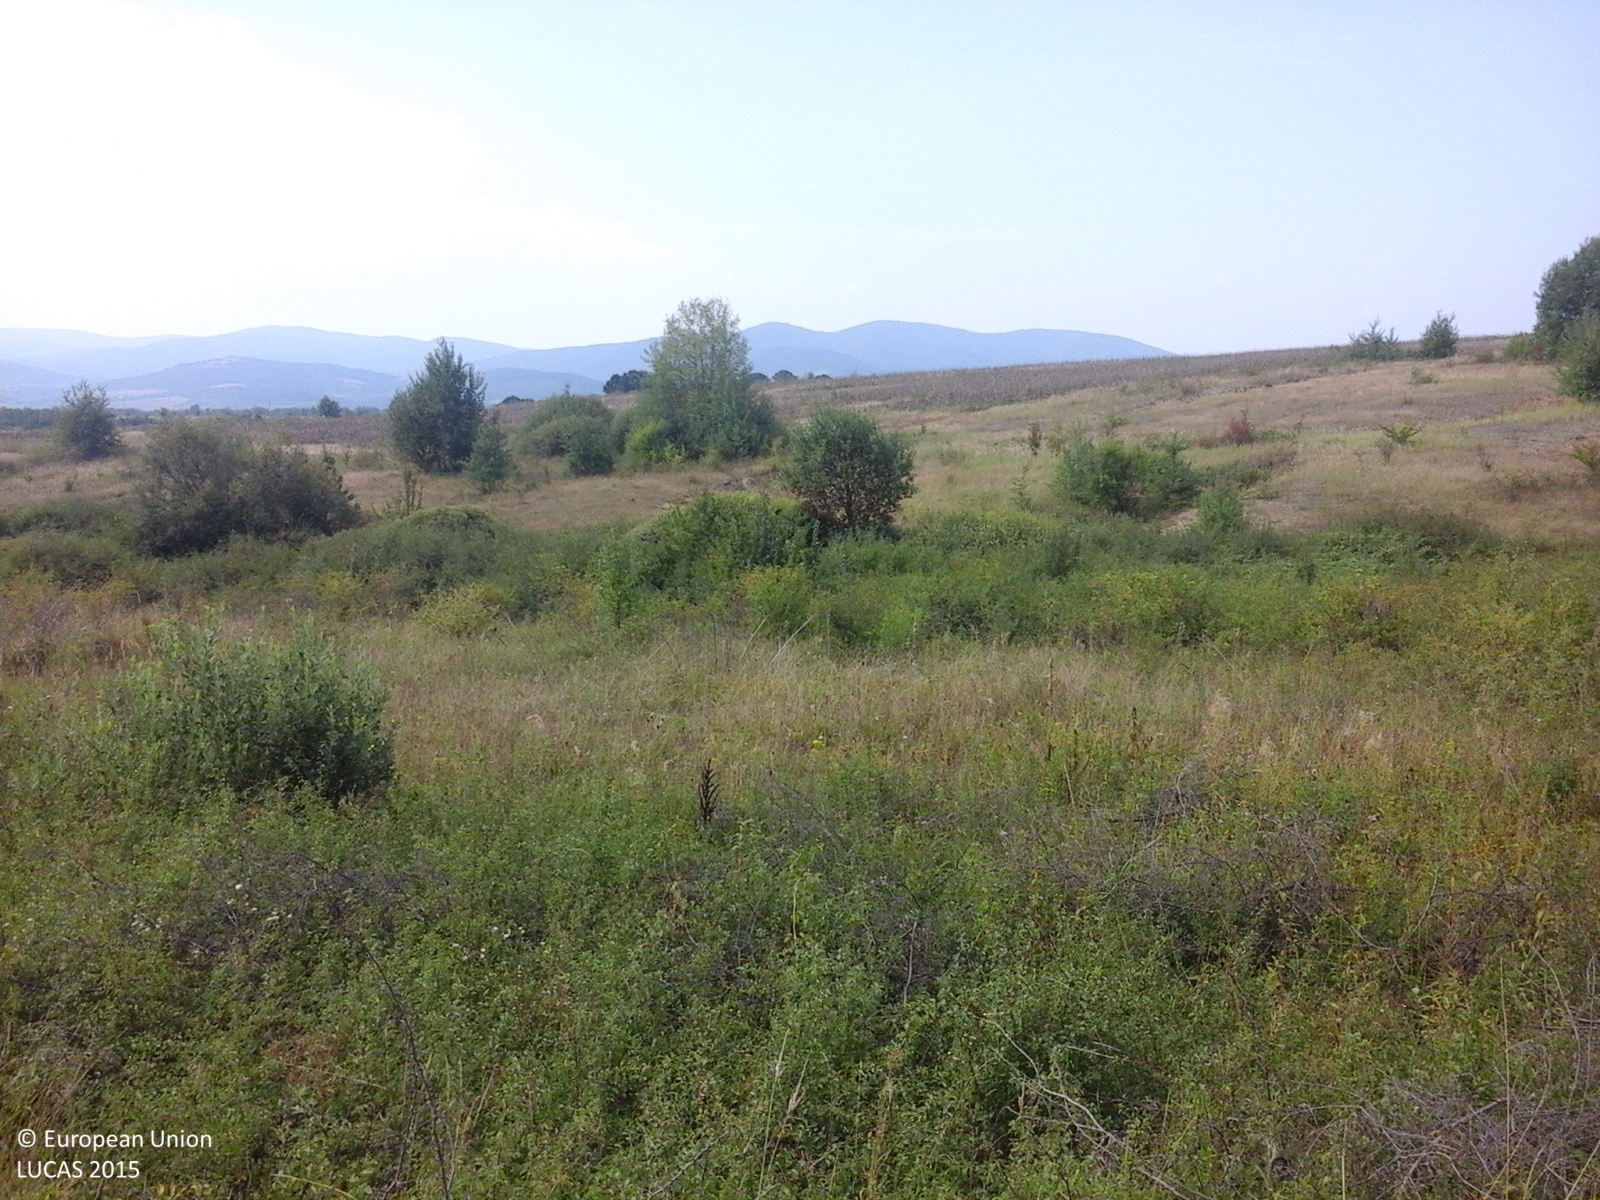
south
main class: Shrubland
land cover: Shrubland with sparse tree cover
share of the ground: > 75 %
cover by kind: shrubs 95 %, broadleaved forest trees 5 %
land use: Forestry
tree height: < 5 m
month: August
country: RO
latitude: 46.3394
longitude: 22.2201
